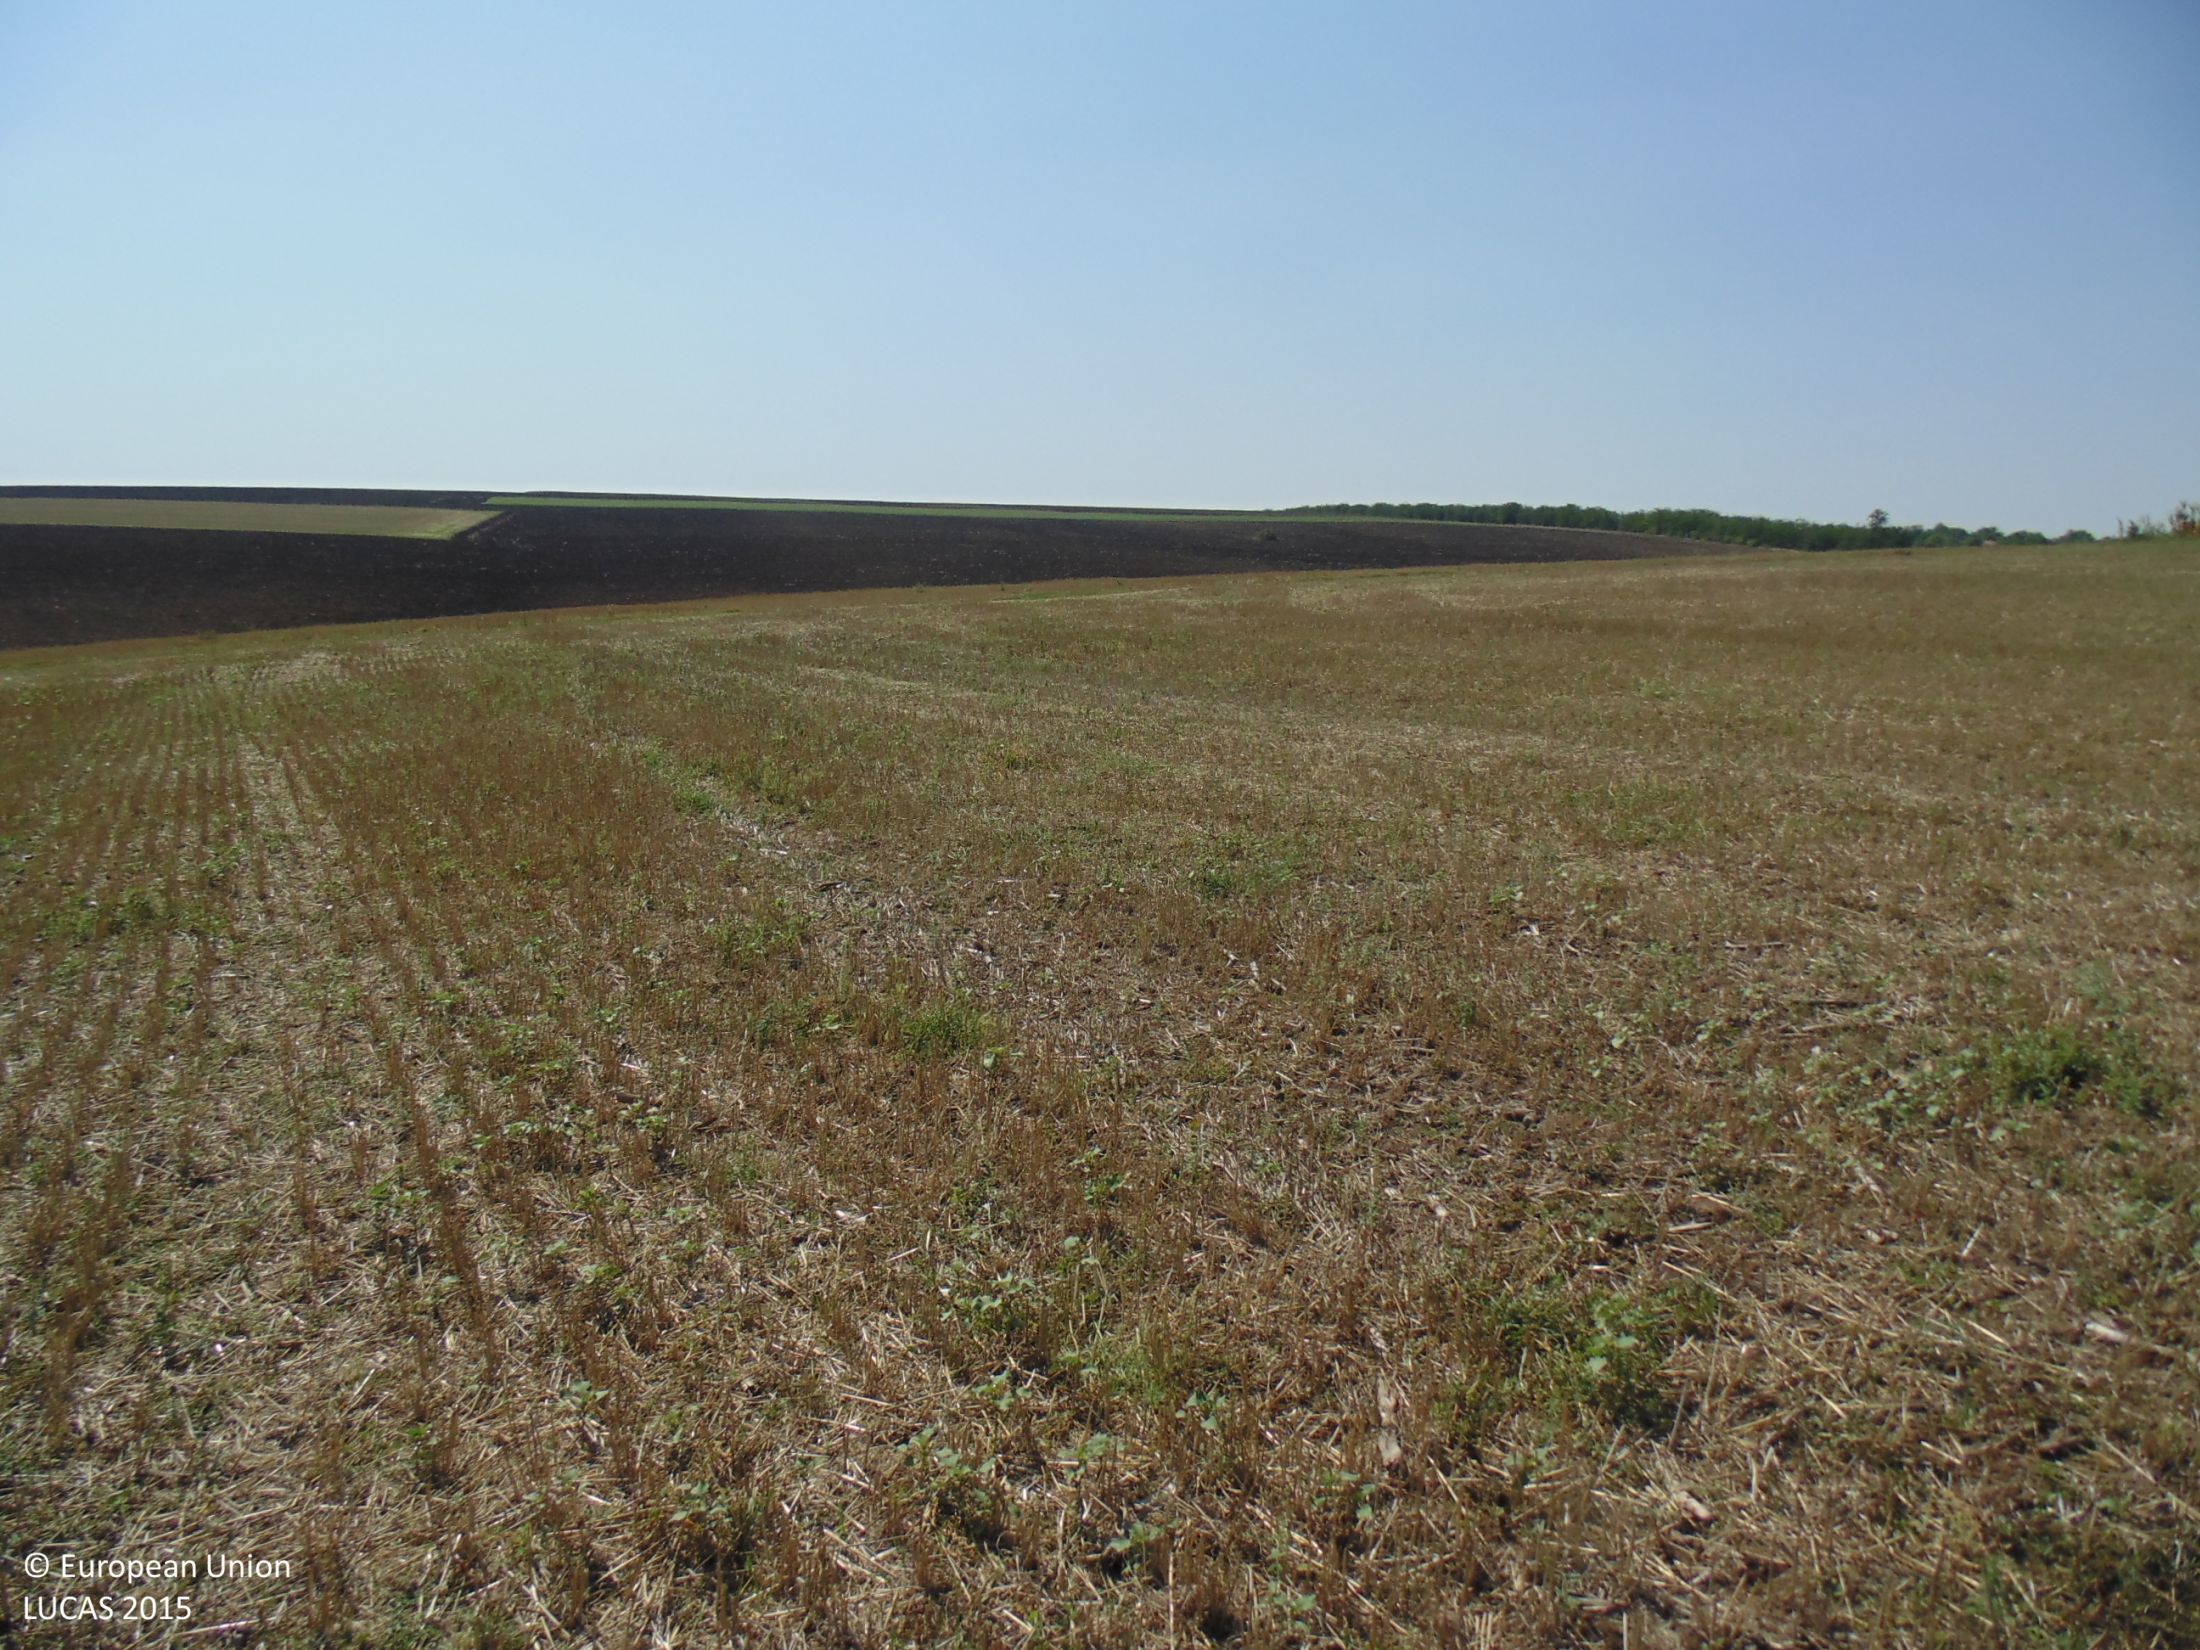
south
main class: Cropland
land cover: Common wheat
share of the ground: 10 - 25 %
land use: Agriculture (excluding fallow land and kitchen gardens)
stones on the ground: < 10 %
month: August
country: BG
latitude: 43.7022
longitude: 27.4680
